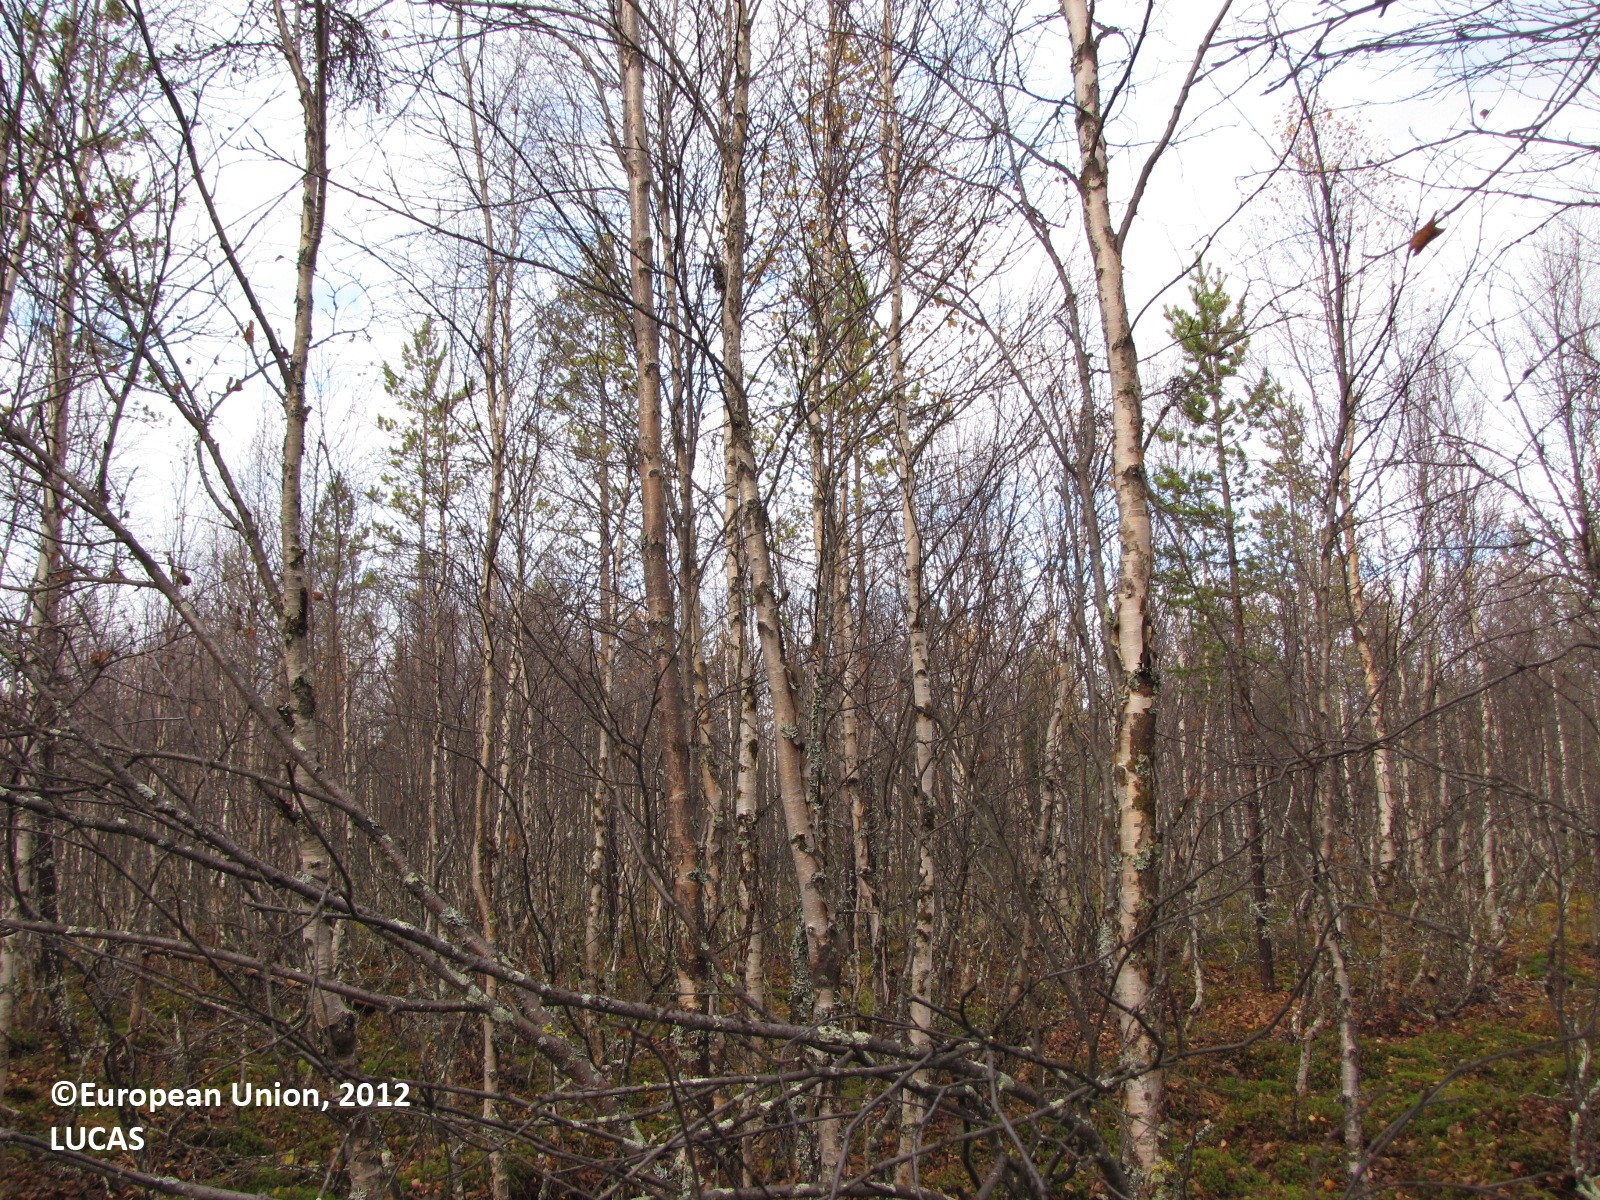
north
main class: Woodland
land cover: Broadleaved woodland
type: boreal forest
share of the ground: > 75 %
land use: Forestry
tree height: > 5 m
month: September
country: FI
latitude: 67.4781
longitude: 25.1319
